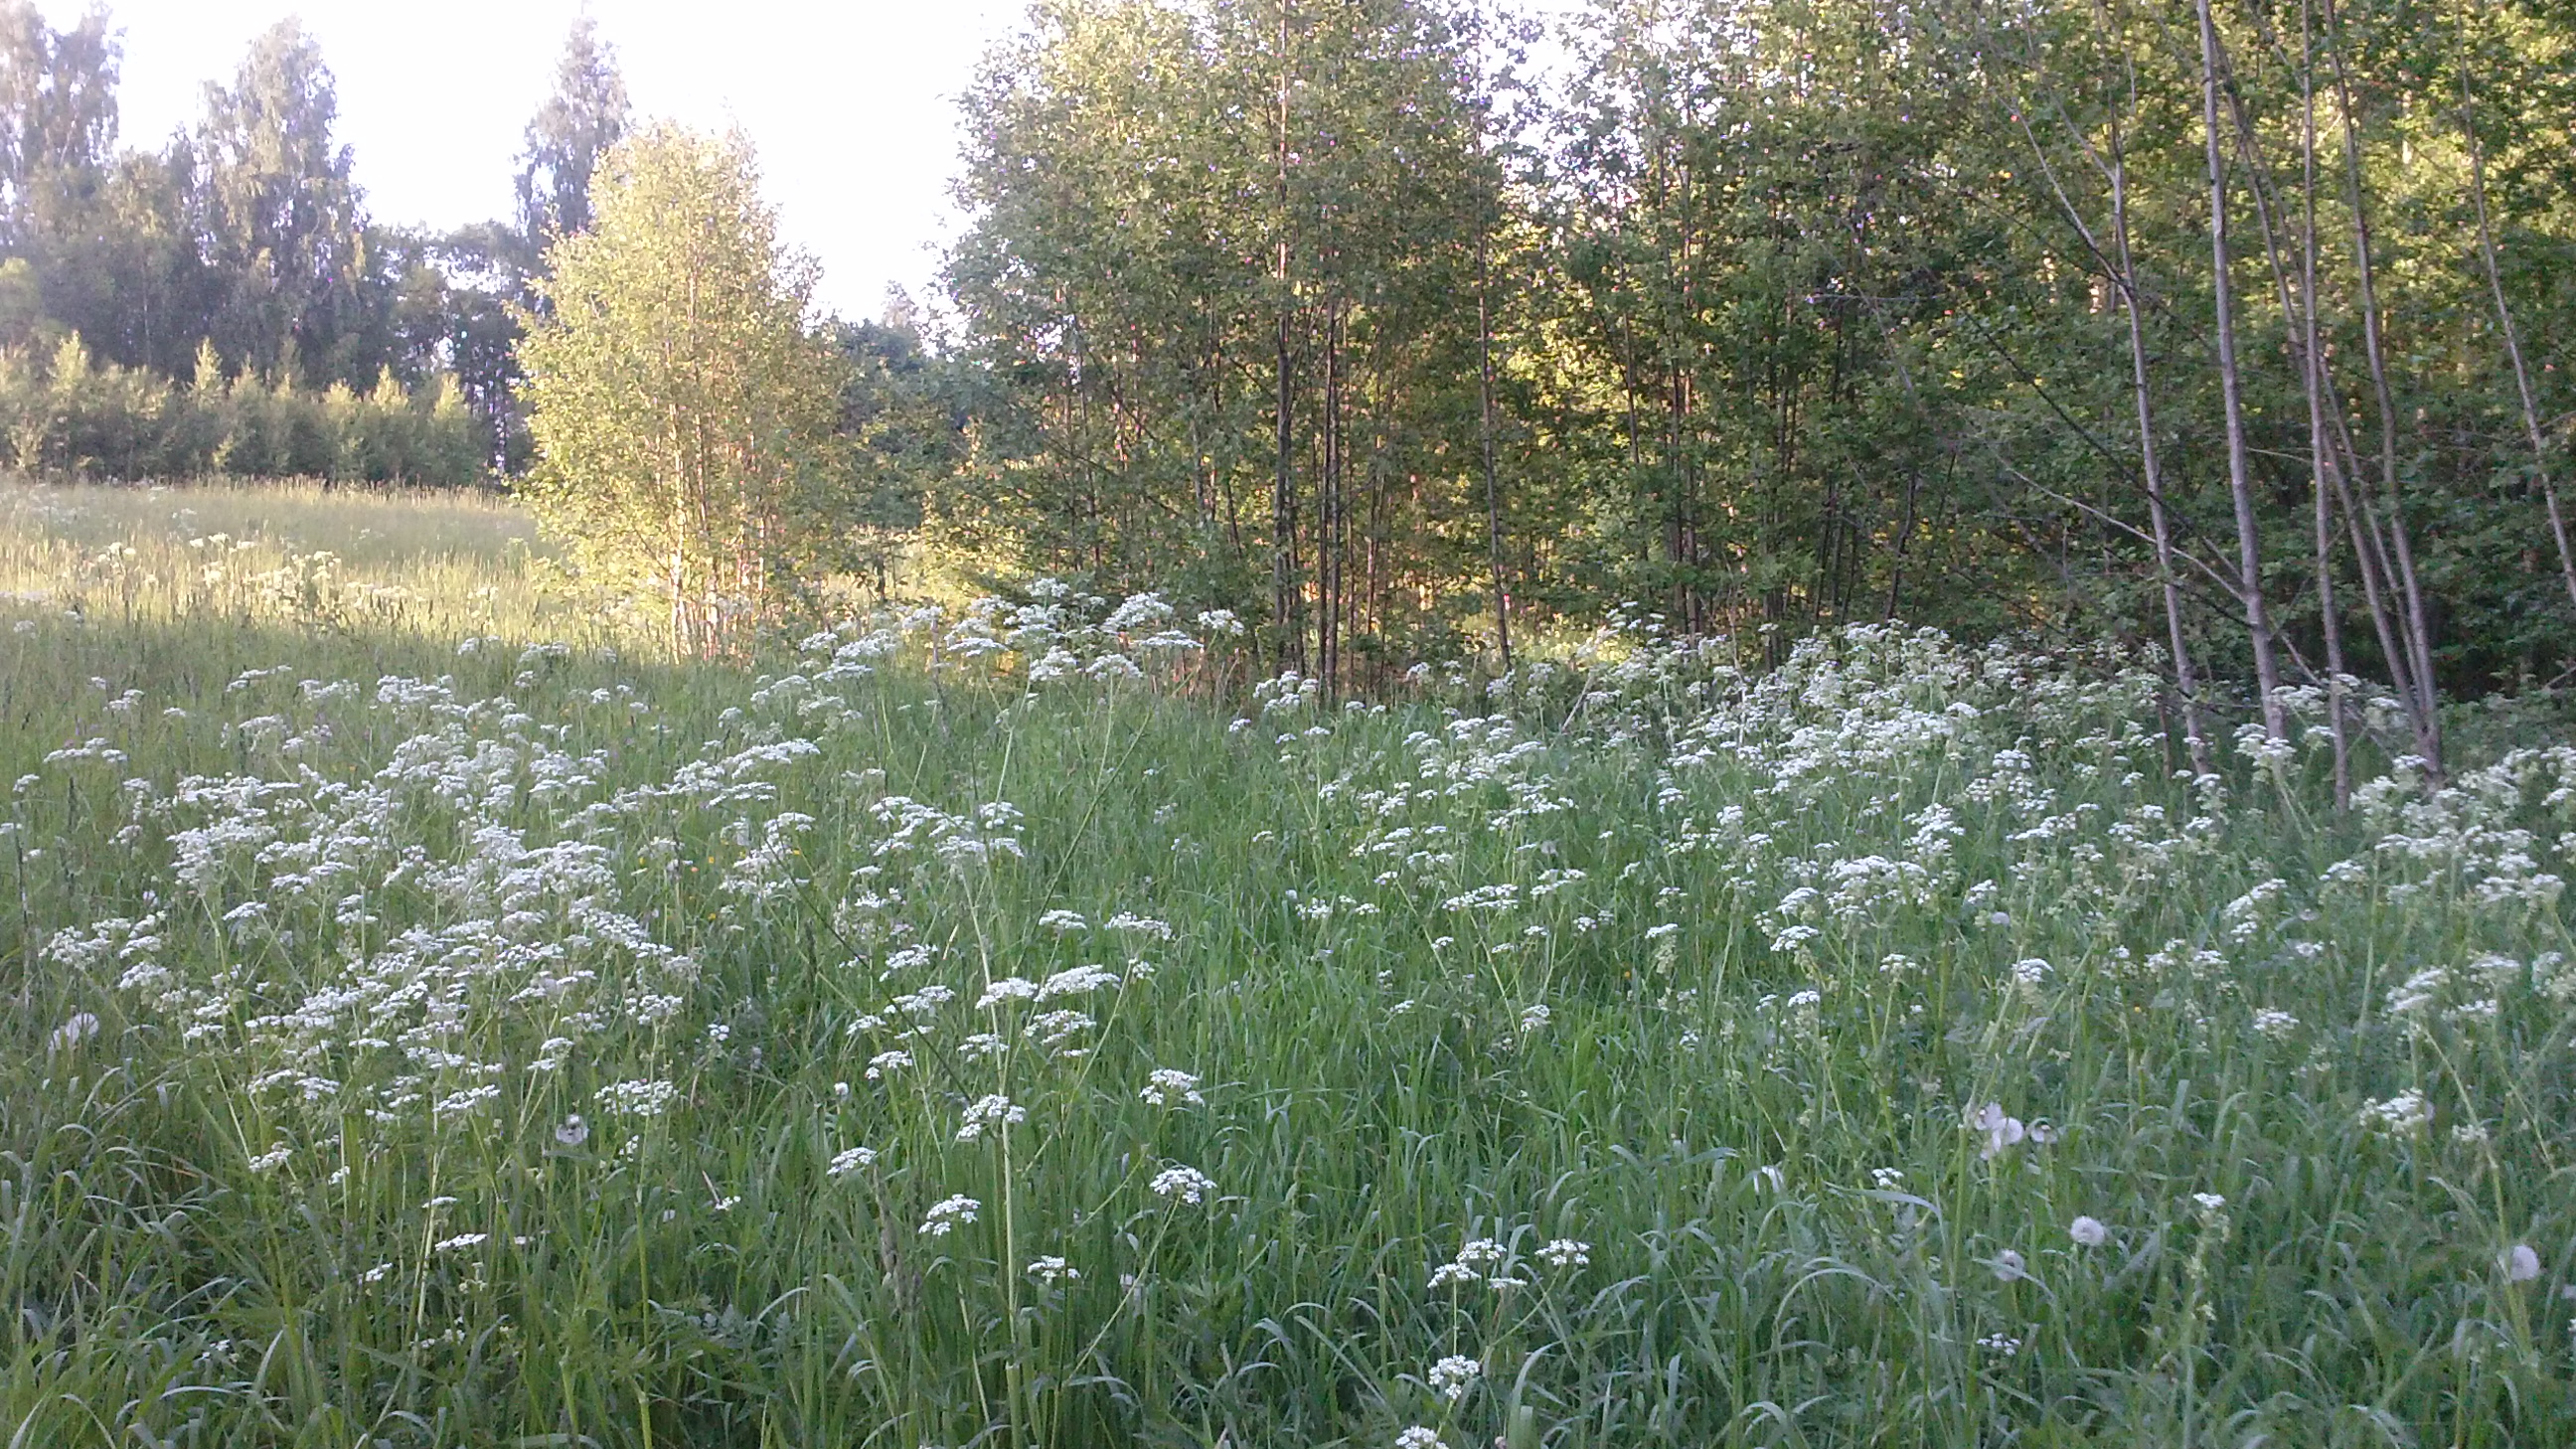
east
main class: Grassland
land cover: Spontaneously vegetated surfaces
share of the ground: > 75 %
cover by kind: herbaceous plants 100 %
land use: Fallow land
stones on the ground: < 10 %
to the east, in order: Spontaneously vegetated surfaces; Broadleaved woodland
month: June
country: LV
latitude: 56.4305
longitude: 27.8840
